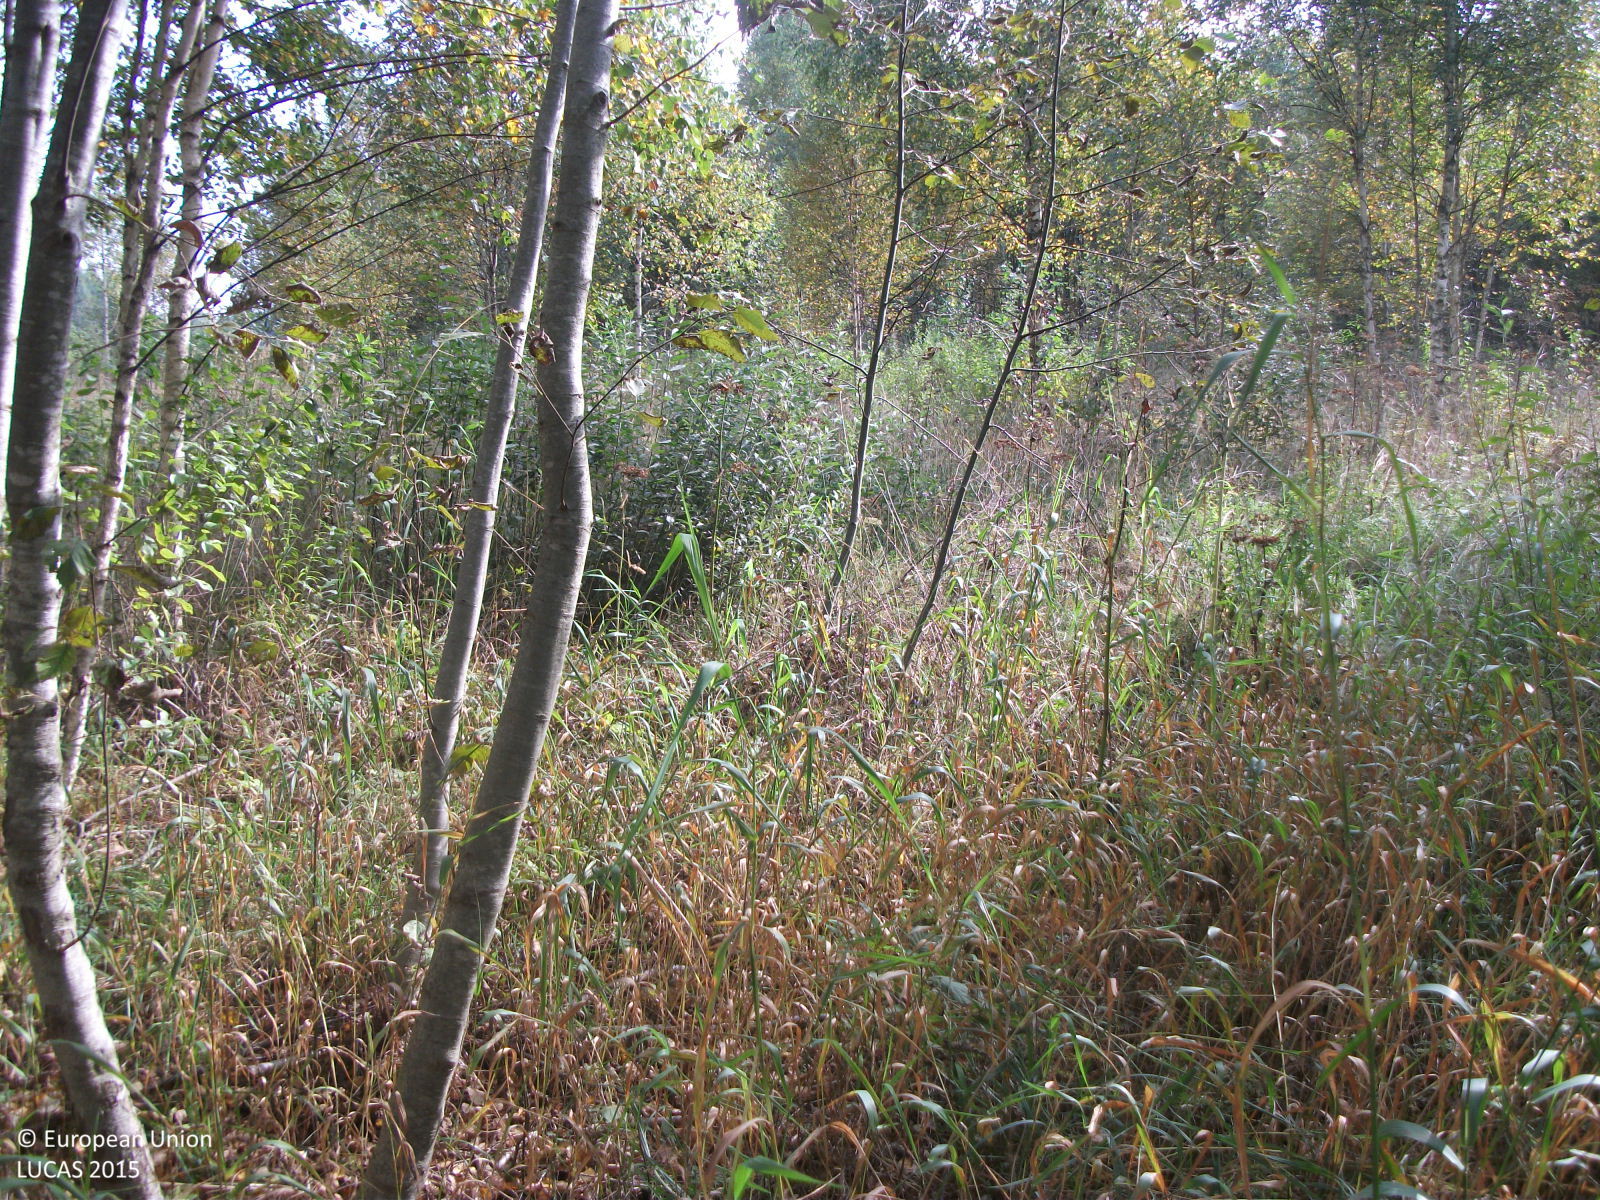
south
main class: Woodland
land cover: Broadleaved woodland
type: non-riverine alder, birch or aspen forest
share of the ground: > 75 %
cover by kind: broadleaved forest trees 90 %, shrubs 5 %, herbaceous plants 5 %
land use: Forestry
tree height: > 5 m
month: September
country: LV
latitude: 57.8438
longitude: 24.8715
